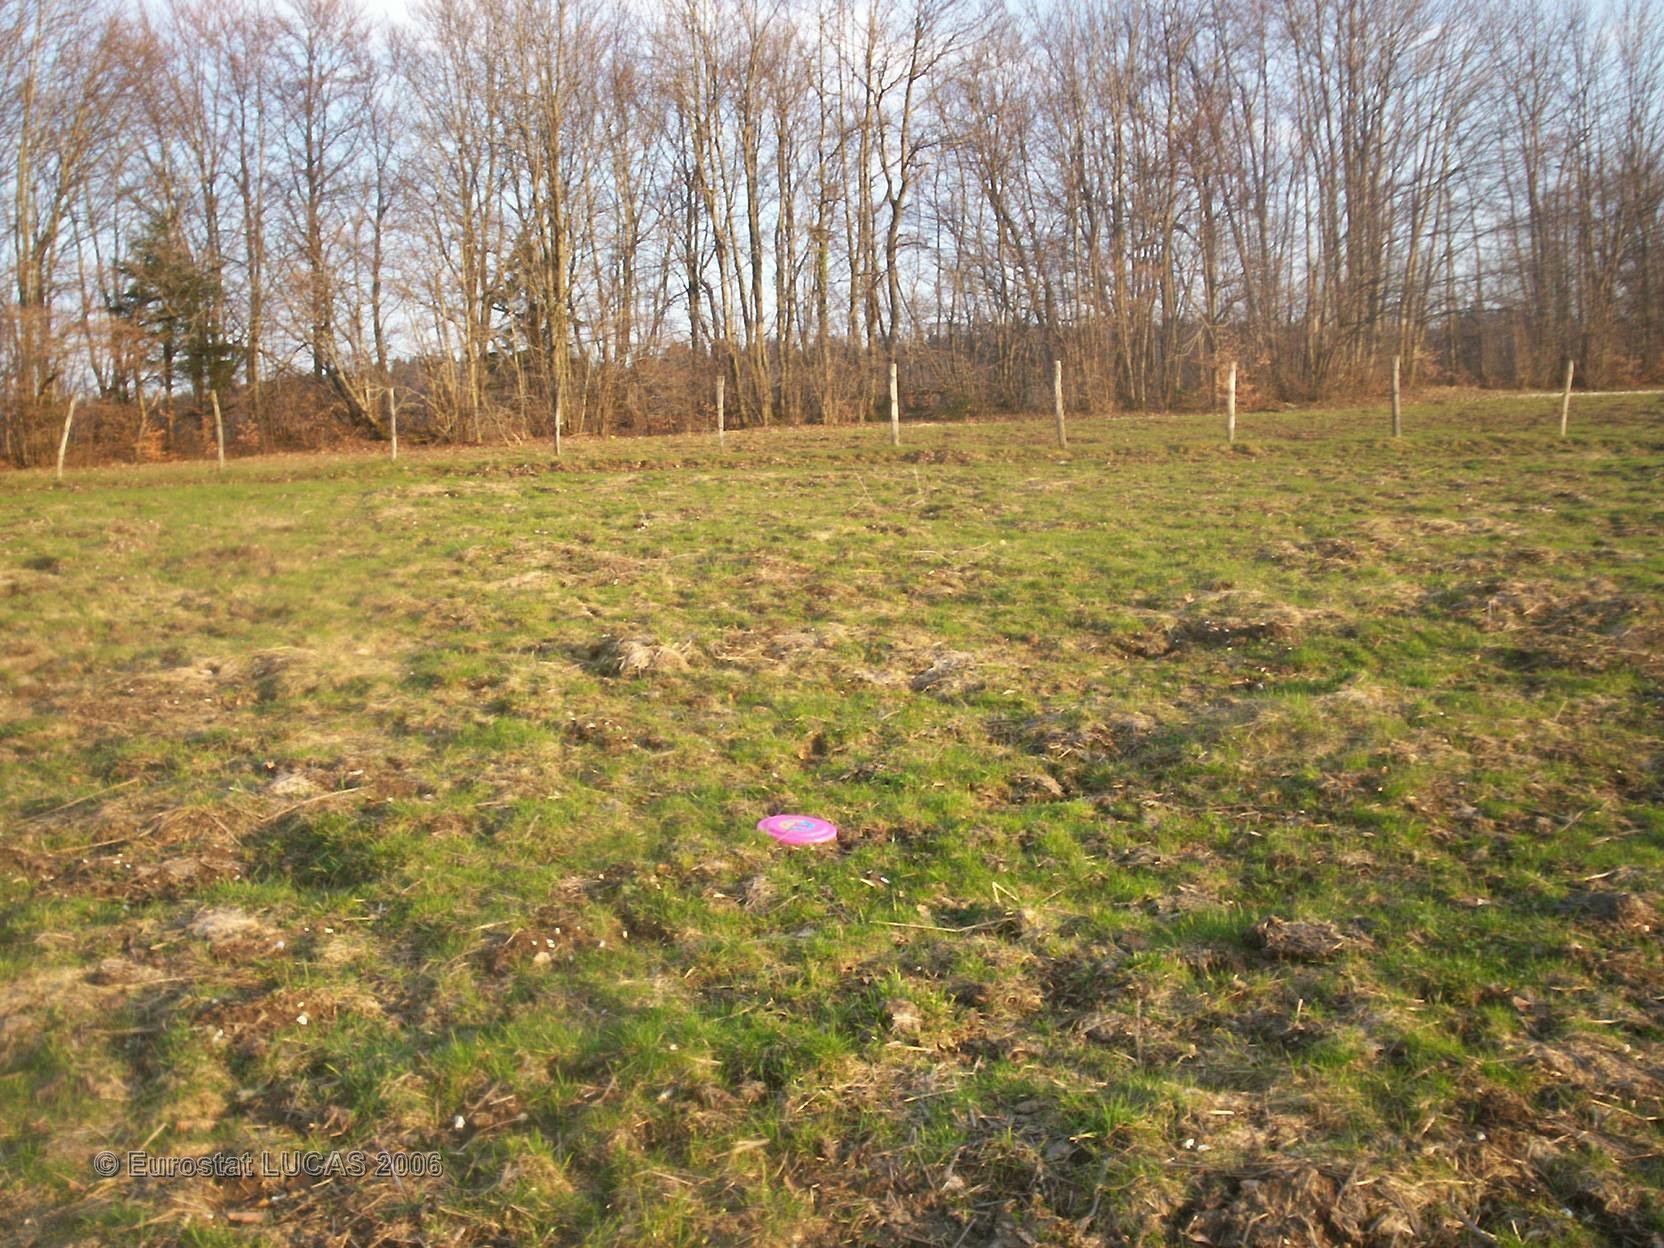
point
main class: Grassland
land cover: Grassland without tree/shrub cover
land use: Agriculture (excluding fallow land and kitchen gardens)
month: April
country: FR
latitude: 47.2800
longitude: 6.9217
